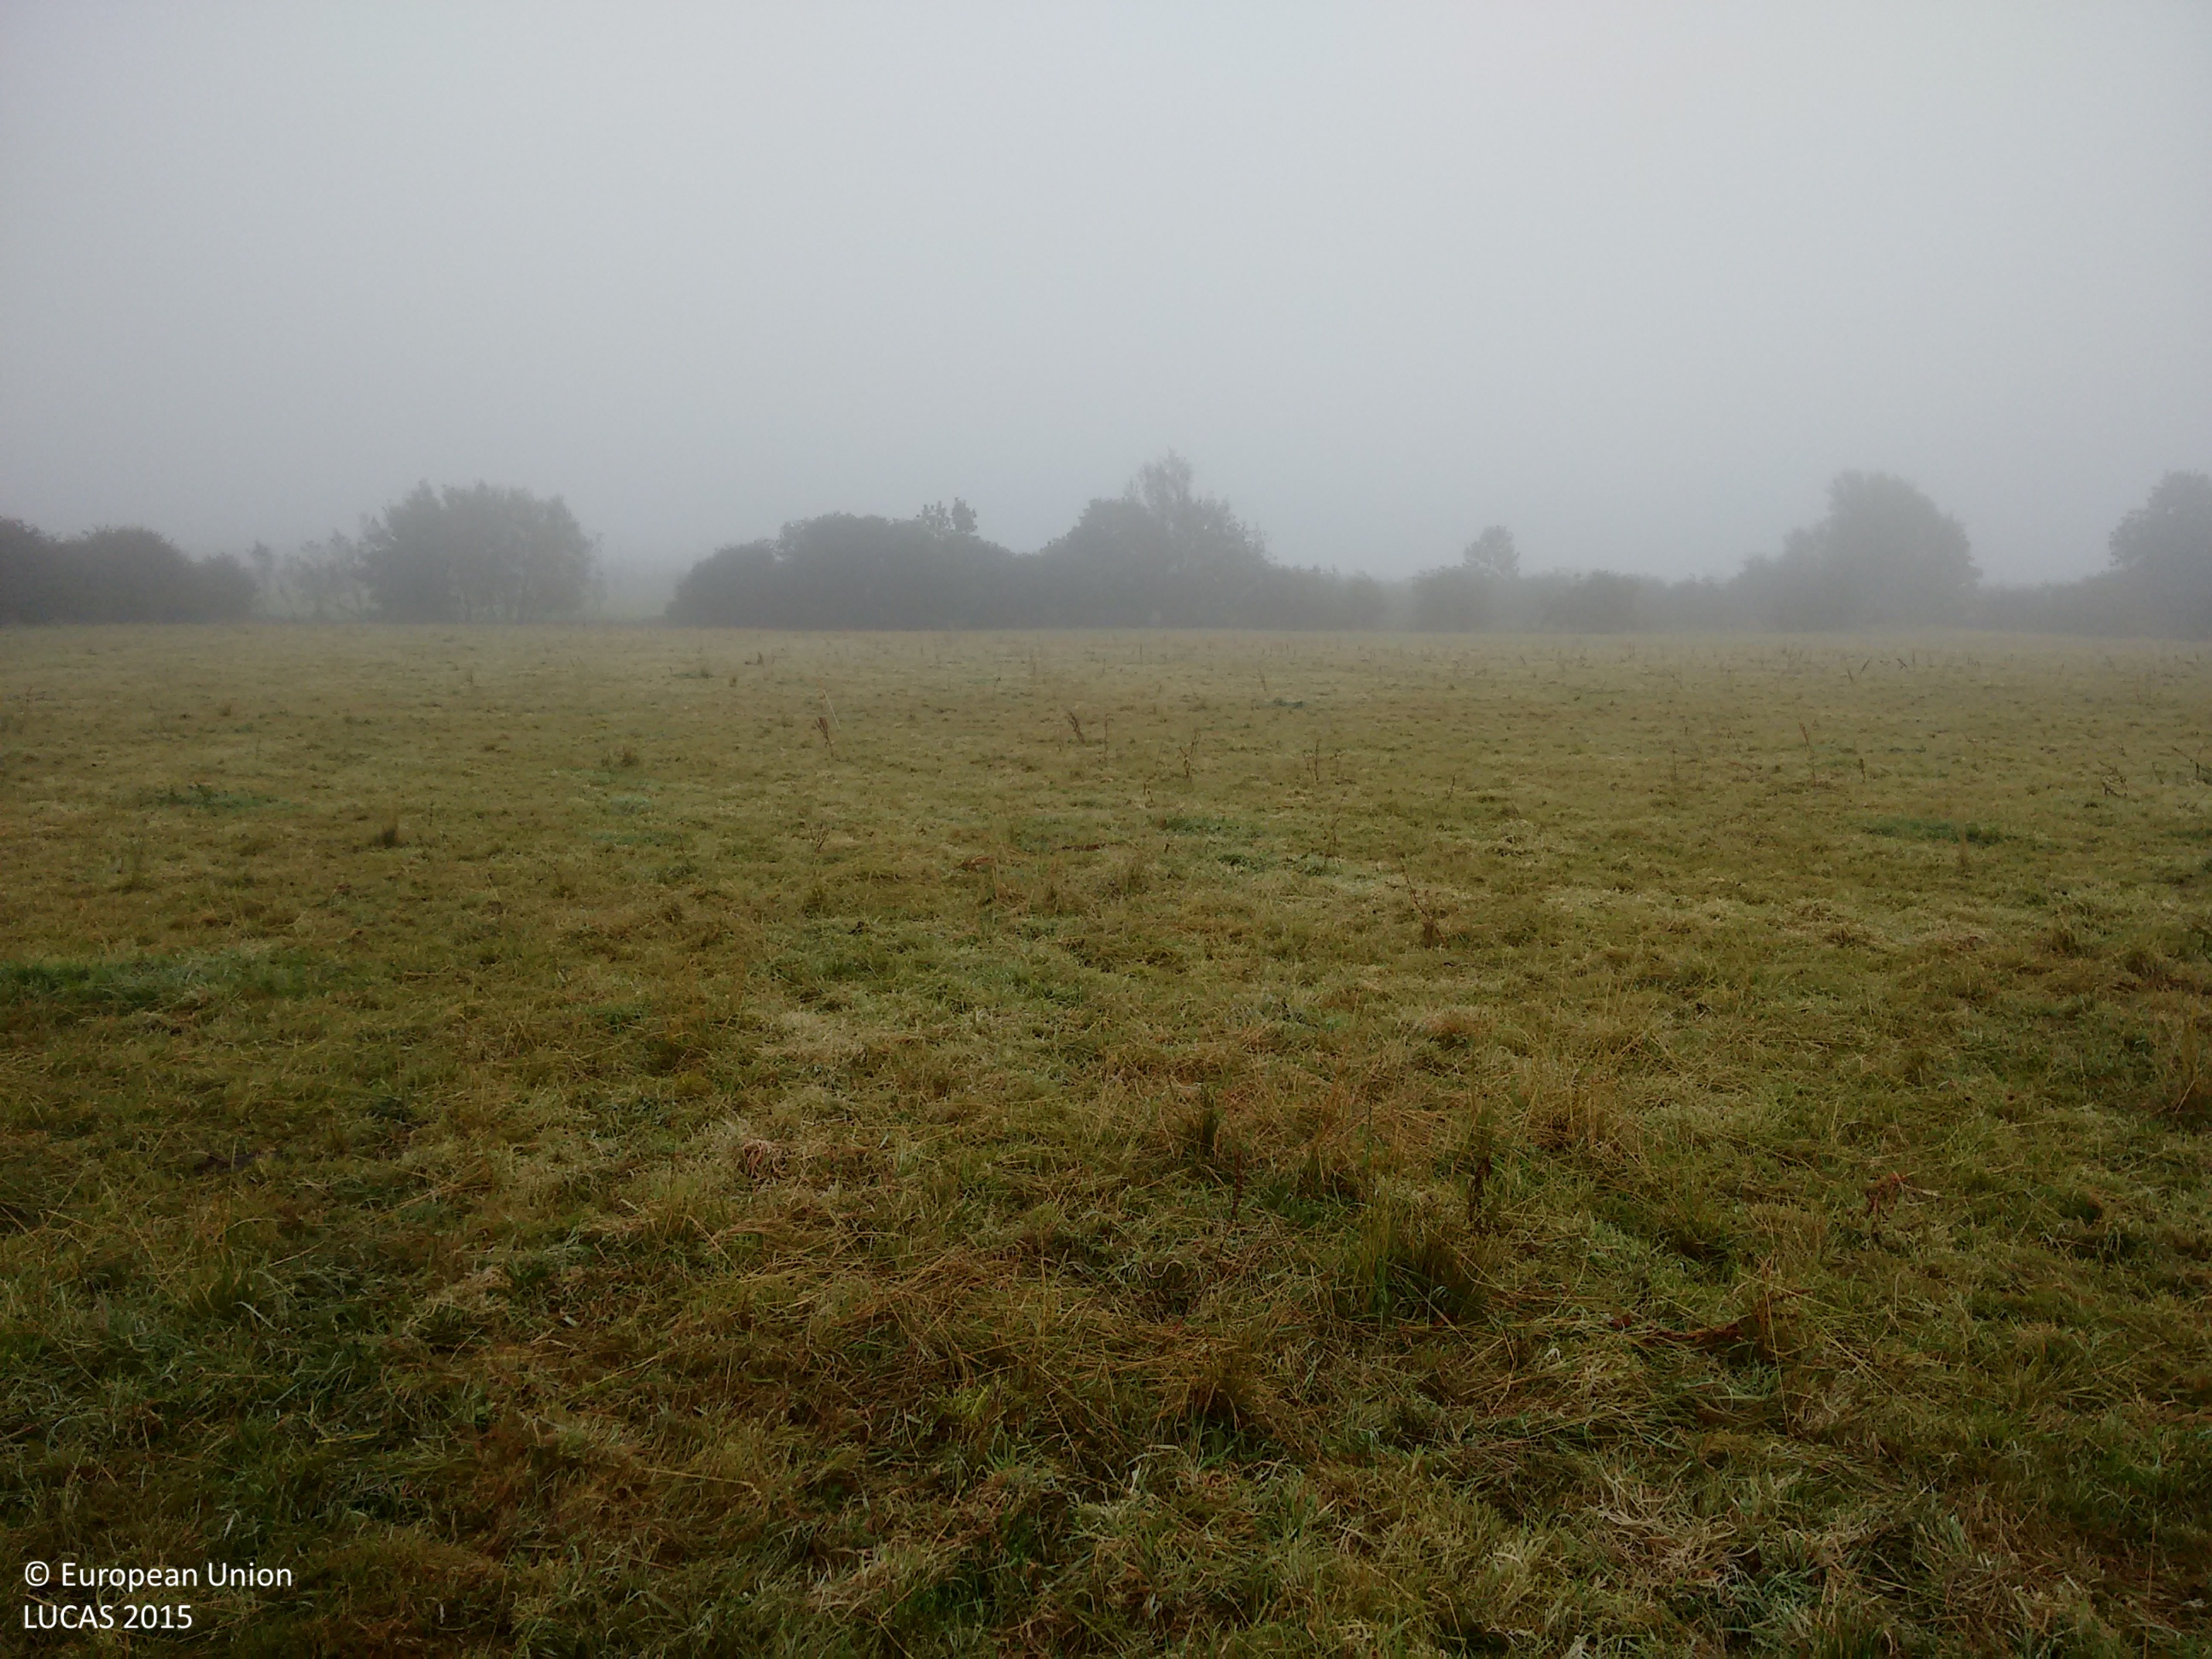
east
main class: Grassland
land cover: Grassland without tree/shrub cover
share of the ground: > 75 %
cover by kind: herbaceous plants 100 %
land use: Agriculture (excluding fallow land and kitchen gardens)
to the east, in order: Grassland without tree/shrub cover; Fences; Broadleaved woodland; Inland fresh running water; Broadleaved woodland; Grassland without tree/shrub cover; Abandoned hedges; Grassland without tree/shrub cover; Abandoned hedges; Grassland without tree/shrub cover
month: October
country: IE
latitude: 52.4448
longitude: -9.0314
